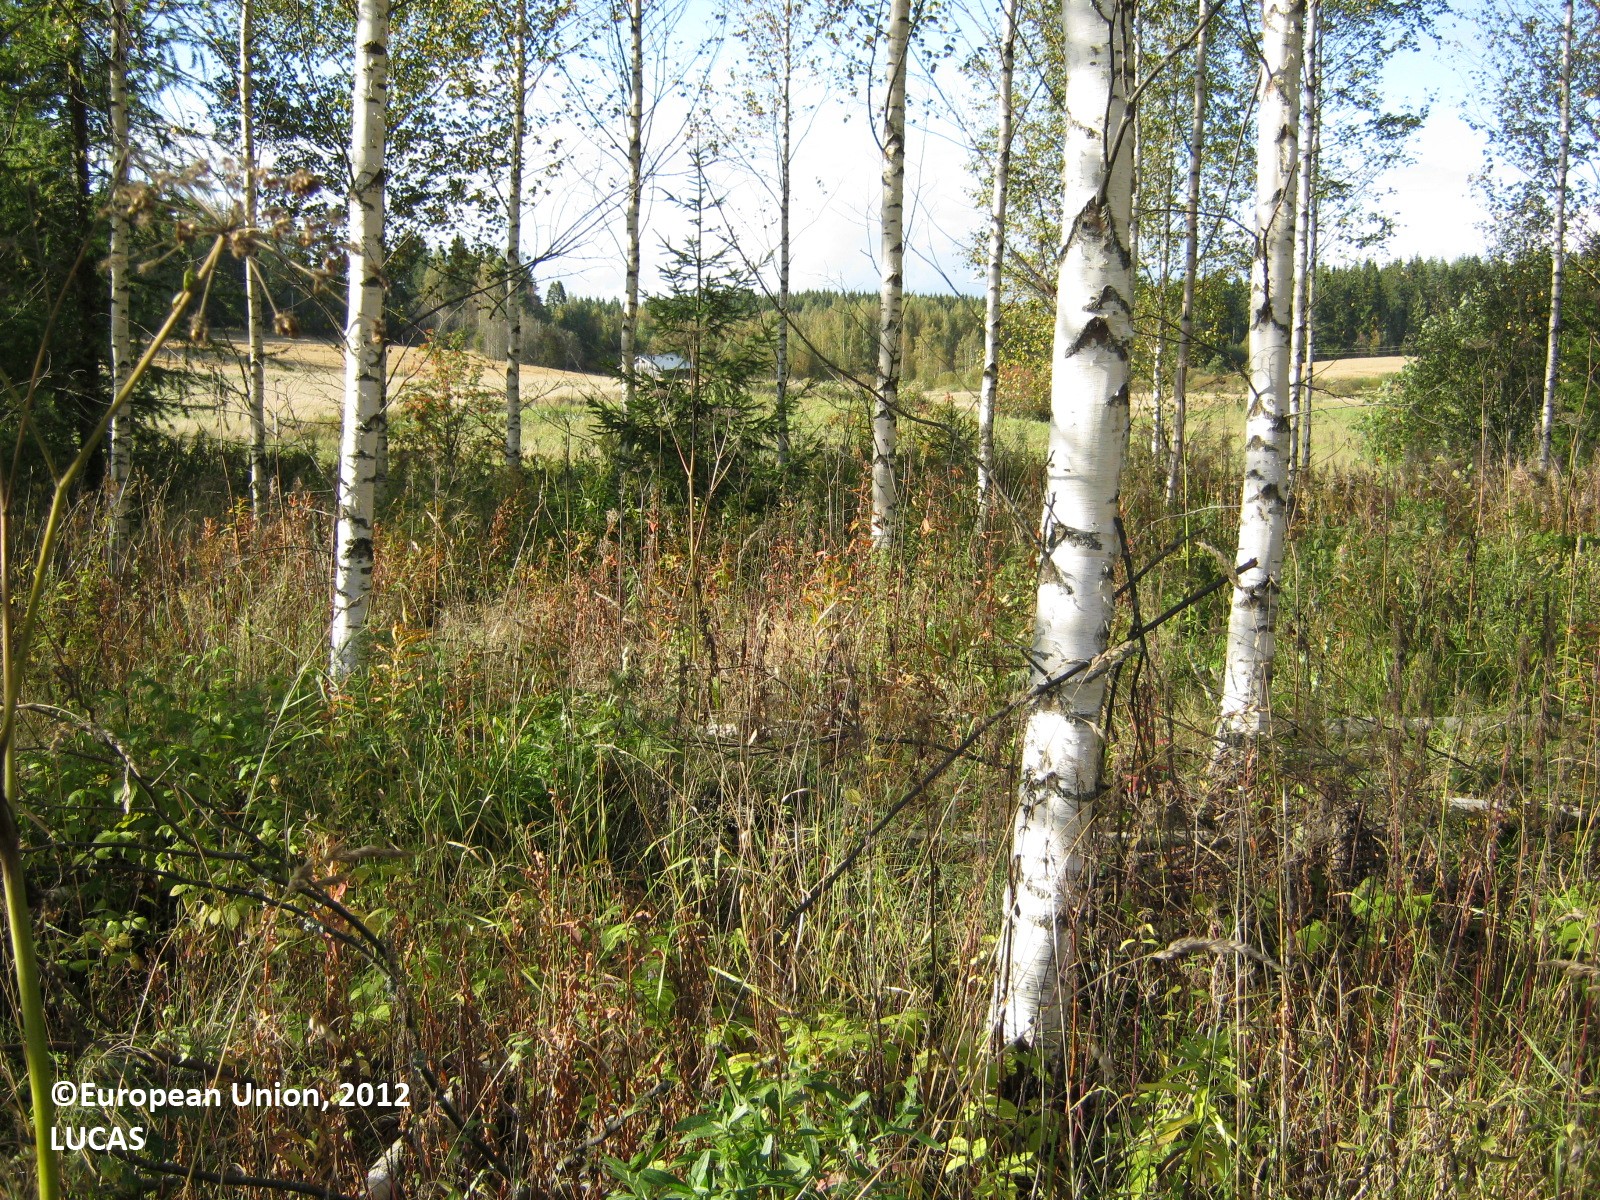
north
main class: Woodland
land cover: Broadleaved woodland
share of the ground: > 75 %
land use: Forestry
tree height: > 5 m
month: September
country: FI
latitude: 60.6665
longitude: 27.9317
